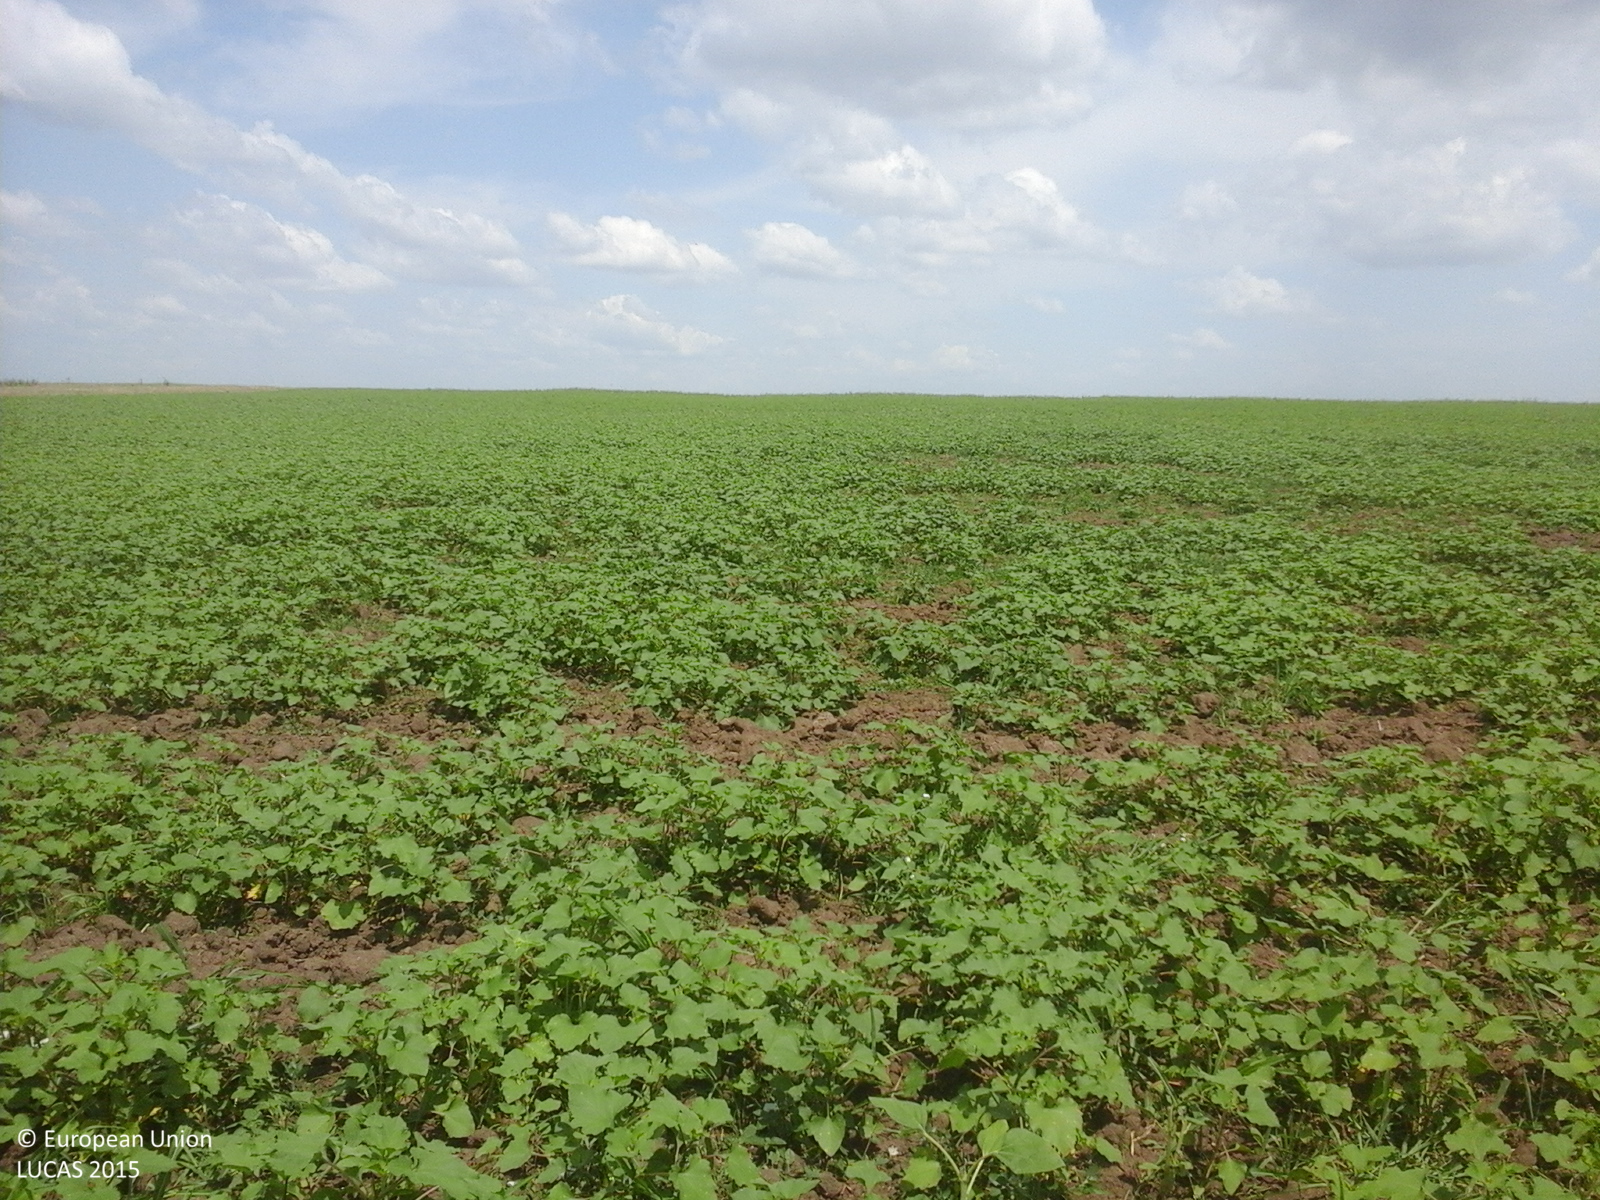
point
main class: Grassland
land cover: Spontaneously vegetated surfaces
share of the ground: > 75 %
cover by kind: herbaceous plants 100 %
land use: Fallow land
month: July
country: RO
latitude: 43.8789
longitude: 24.2107
